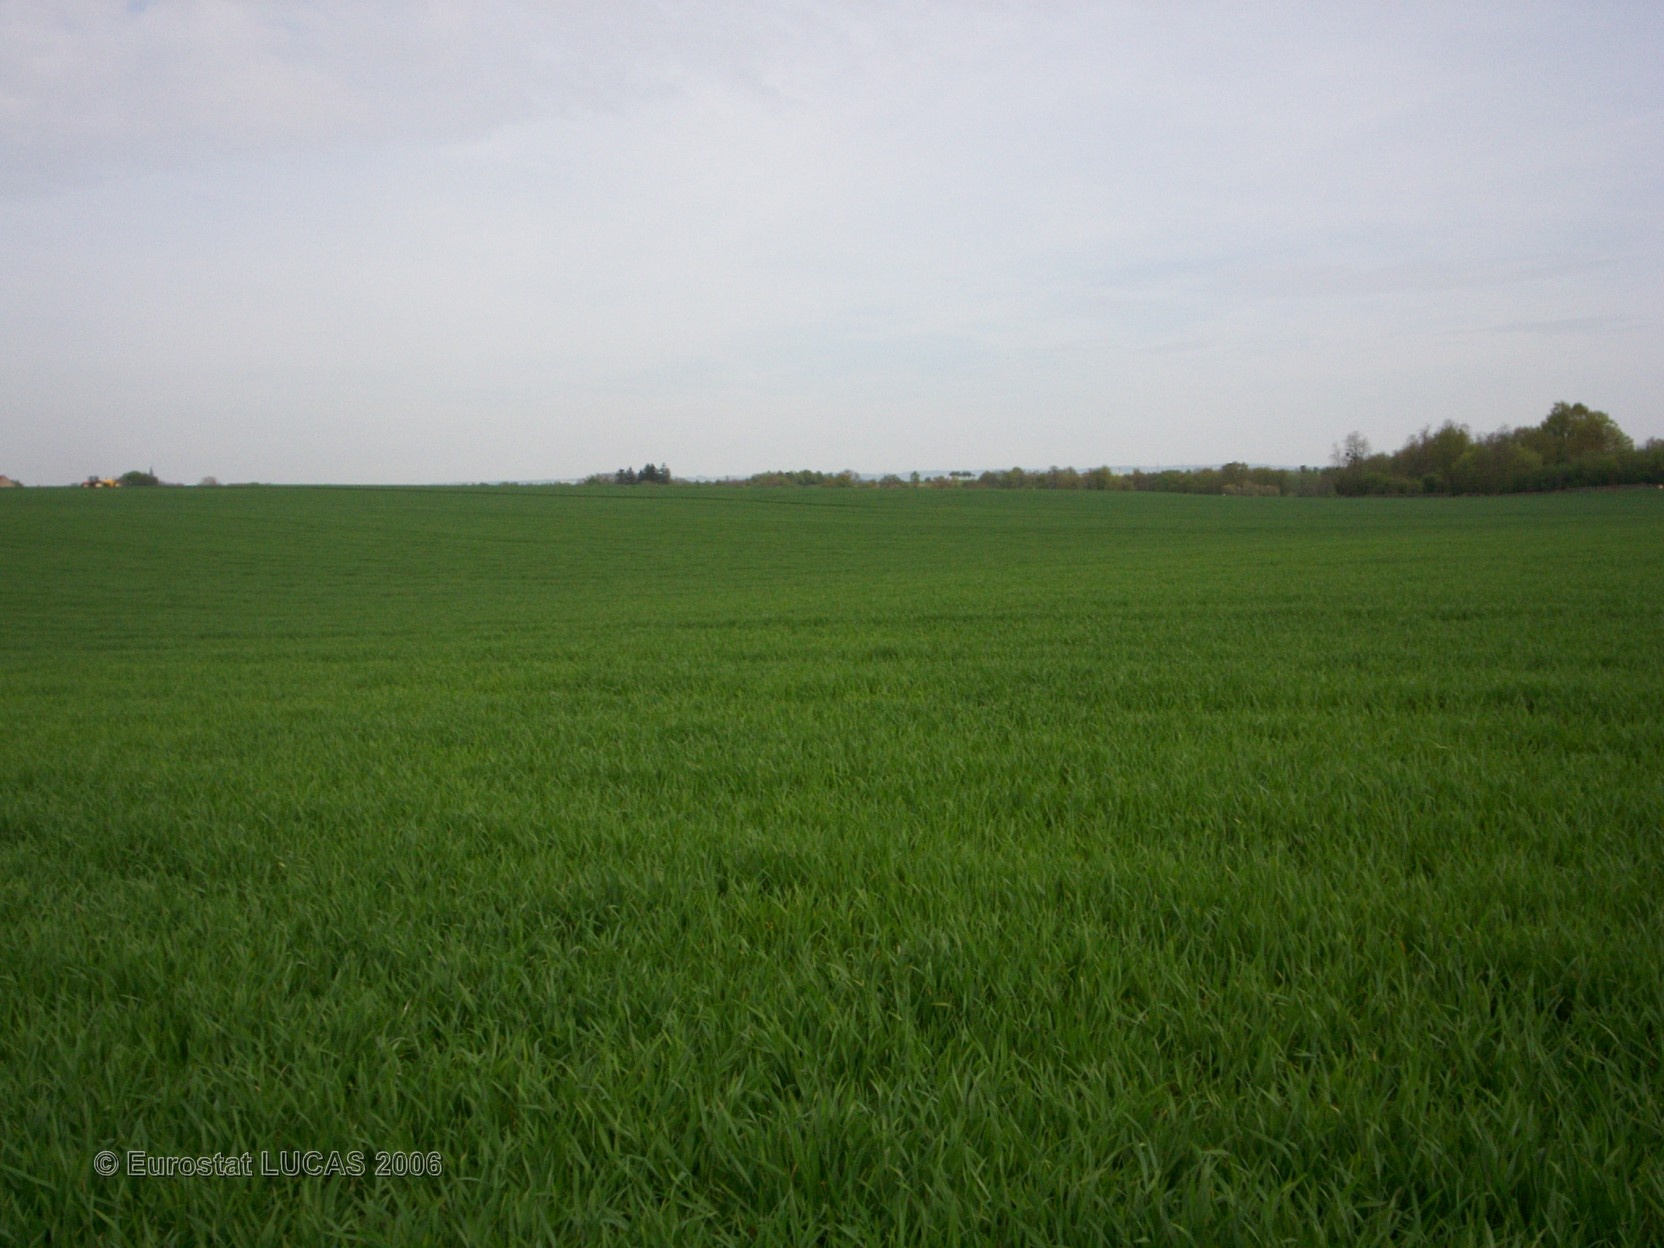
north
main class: Cropland
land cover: Common wheat
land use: Agriculture (excluding fallow land and kitchen gardens)
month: May
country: FR
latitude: 47.3194
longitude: 3.0758
